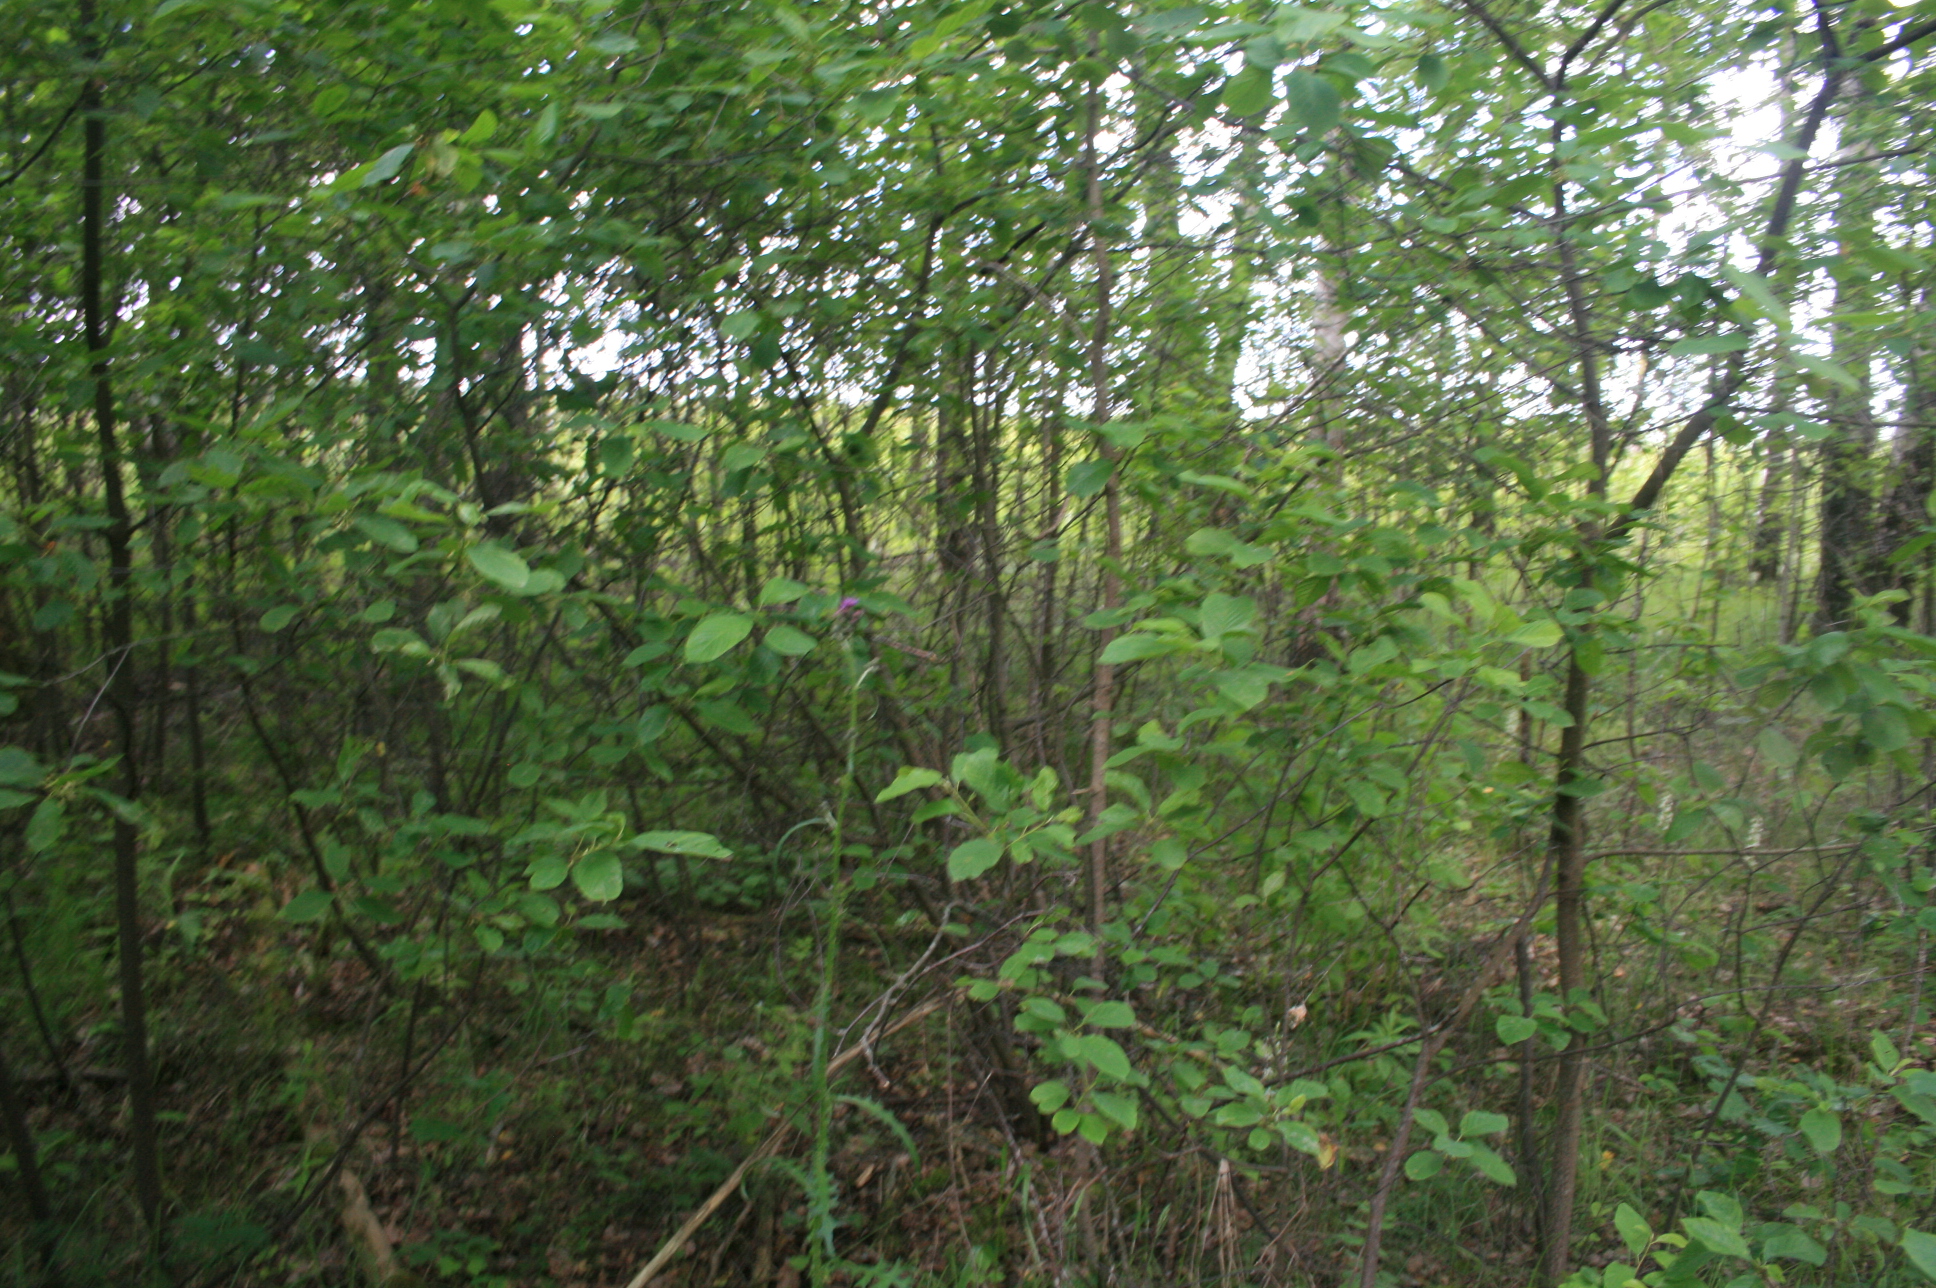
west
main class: Woodland
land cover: Broadleaved woodland
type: non-riverine alder, birch or aspen forest
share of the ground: > 75 %
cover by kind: broadleaved forest trees 90 %, herbaceous plants 10 %
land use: Forestry
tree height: > 5 m
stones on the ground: < 10 %
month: June
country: LT
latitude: 55.3324
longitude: 21.7945
